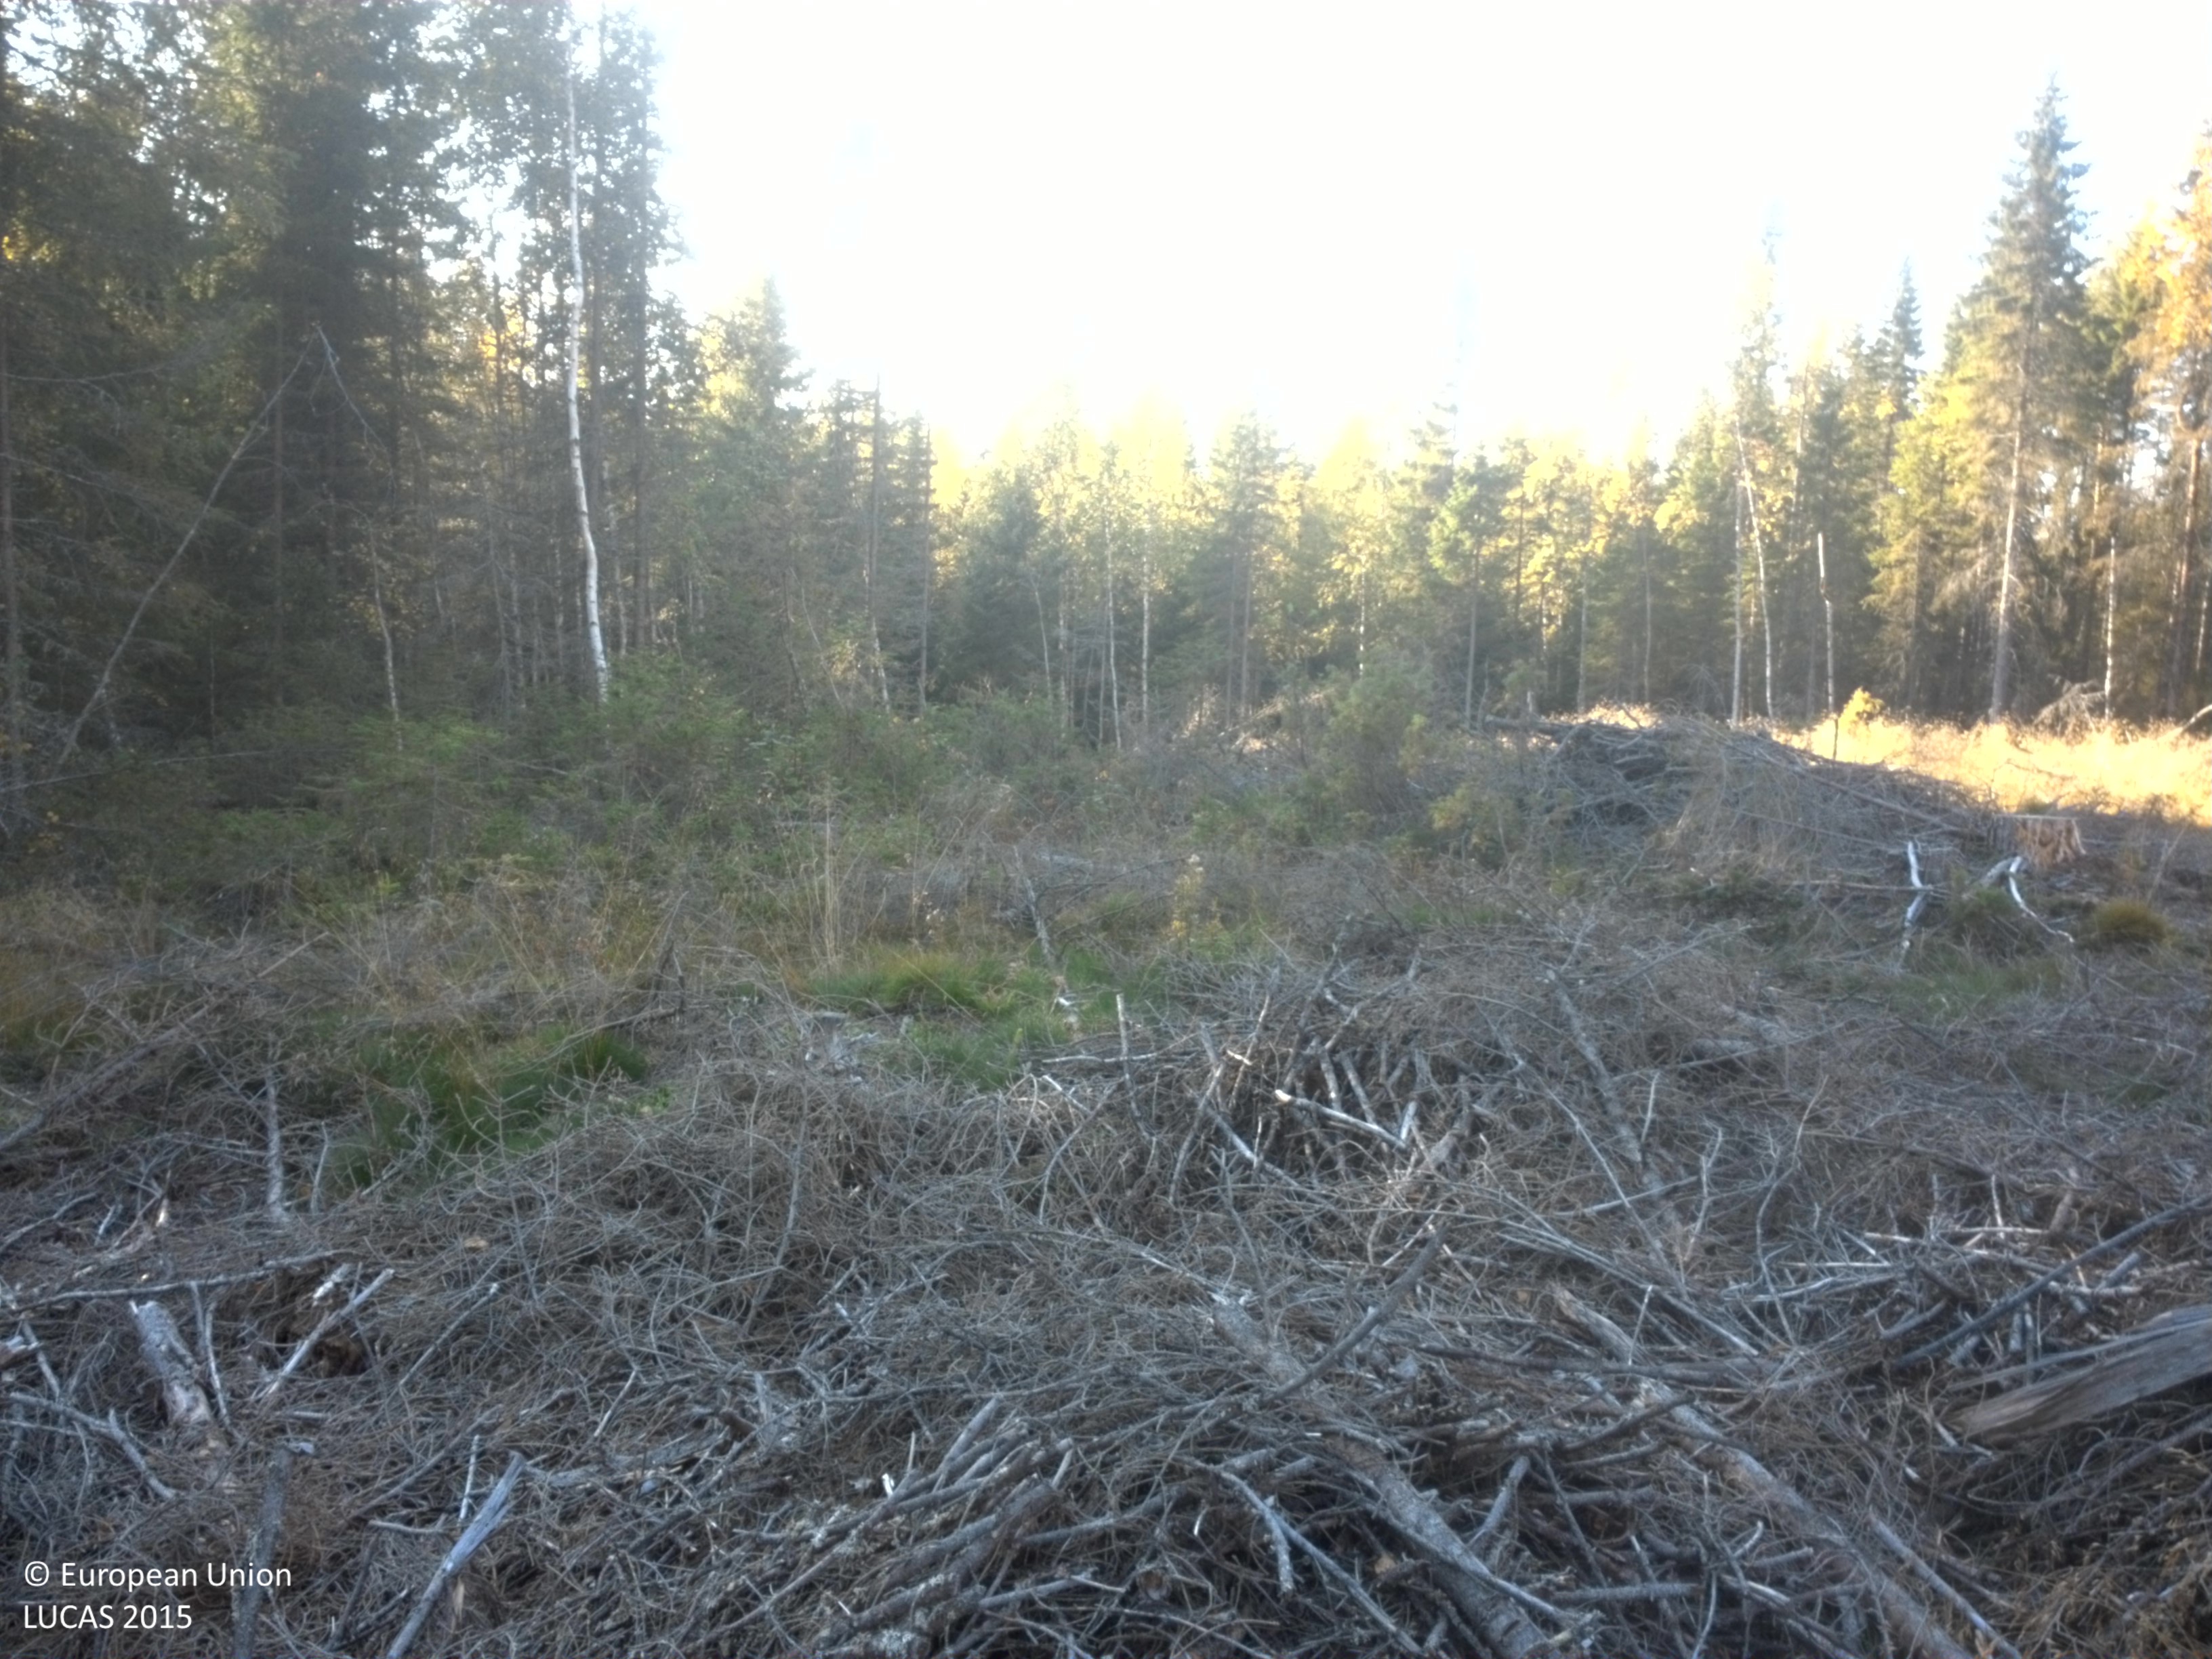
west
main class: Grassland
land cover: Grassland without tree/shrub cover
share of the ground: 50 - 75 %
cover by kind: herbaceous plants 60 %, lichens and mosses 15 %, shrubs 5 %
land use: Forestry
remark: Clear cut
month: September
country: SE
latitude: 64.3046
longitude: 20.5006
